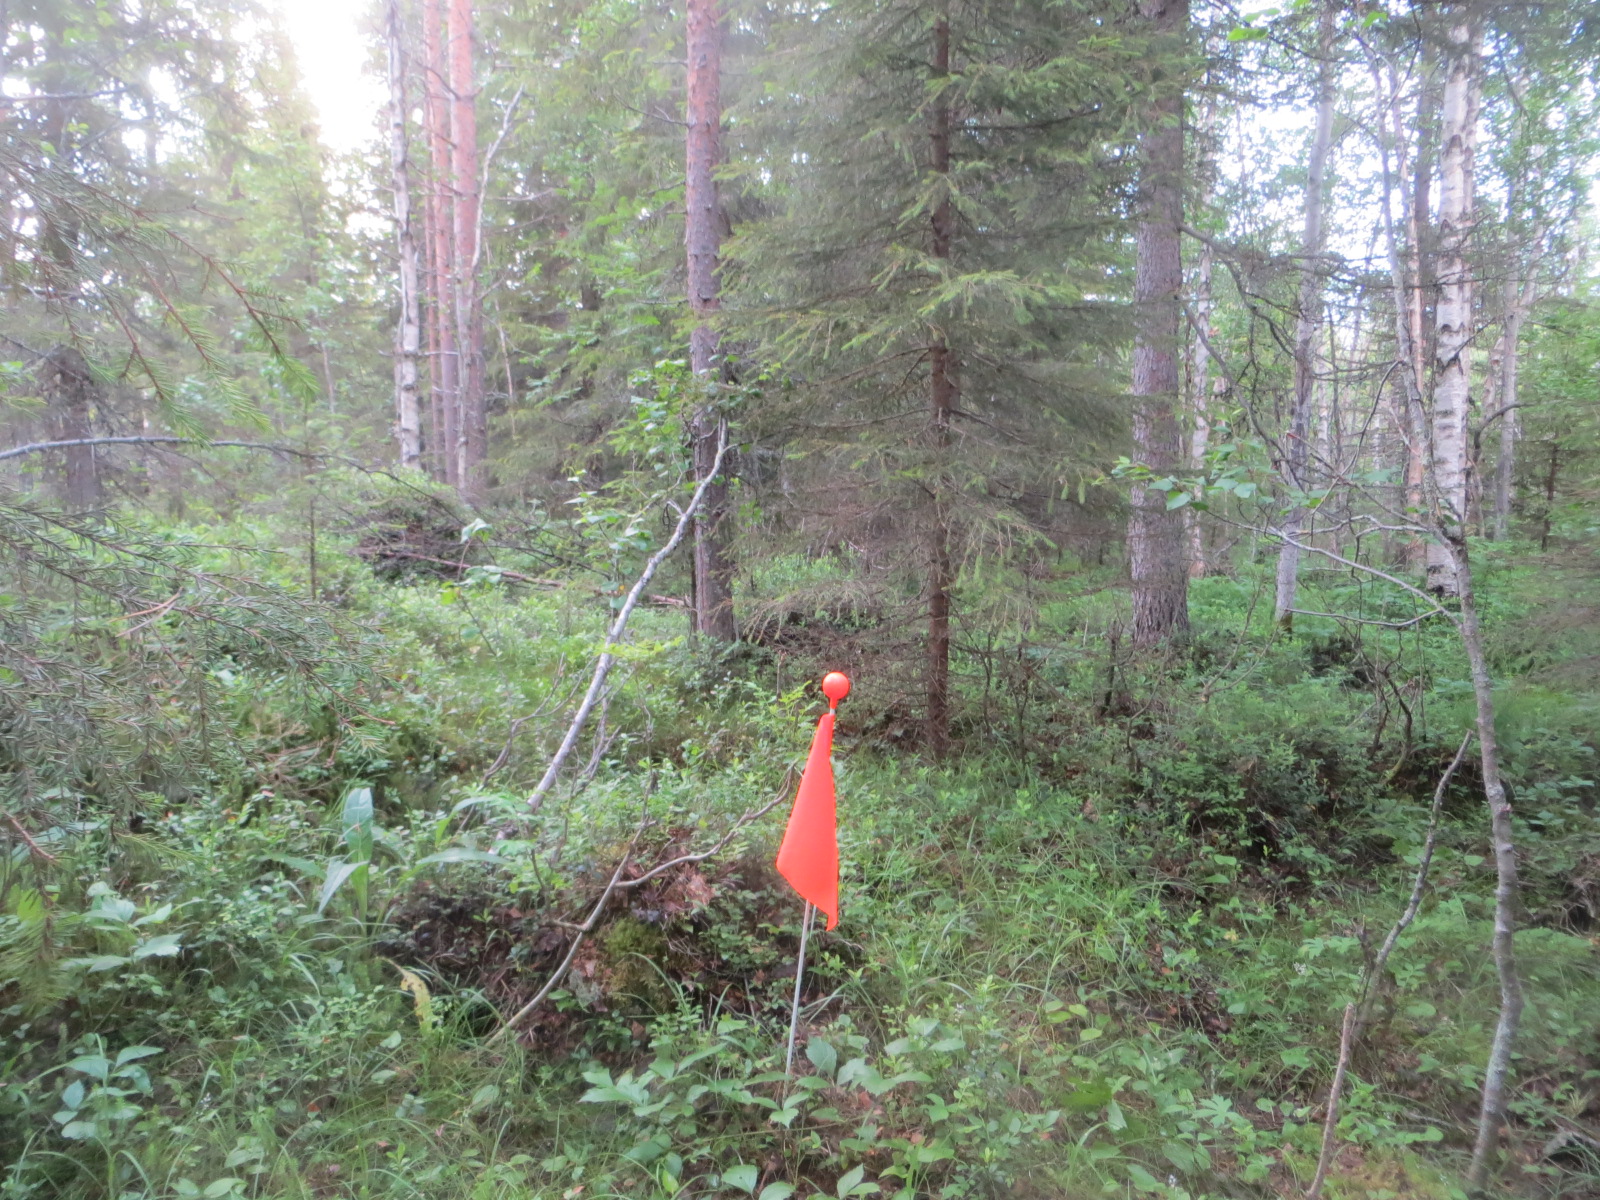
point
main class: Woodland
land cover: Other mixed woodland
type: boreal forest
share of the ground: 50 - 75 %
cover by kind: coniferous forest trees 40 %, broadleaved forest trees 30 %, shrubs 20 %, herbaceous plants 10 %
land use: Forestry
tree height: > 5 m
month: July
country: FI
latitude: 66.3127
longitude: 24.4791
